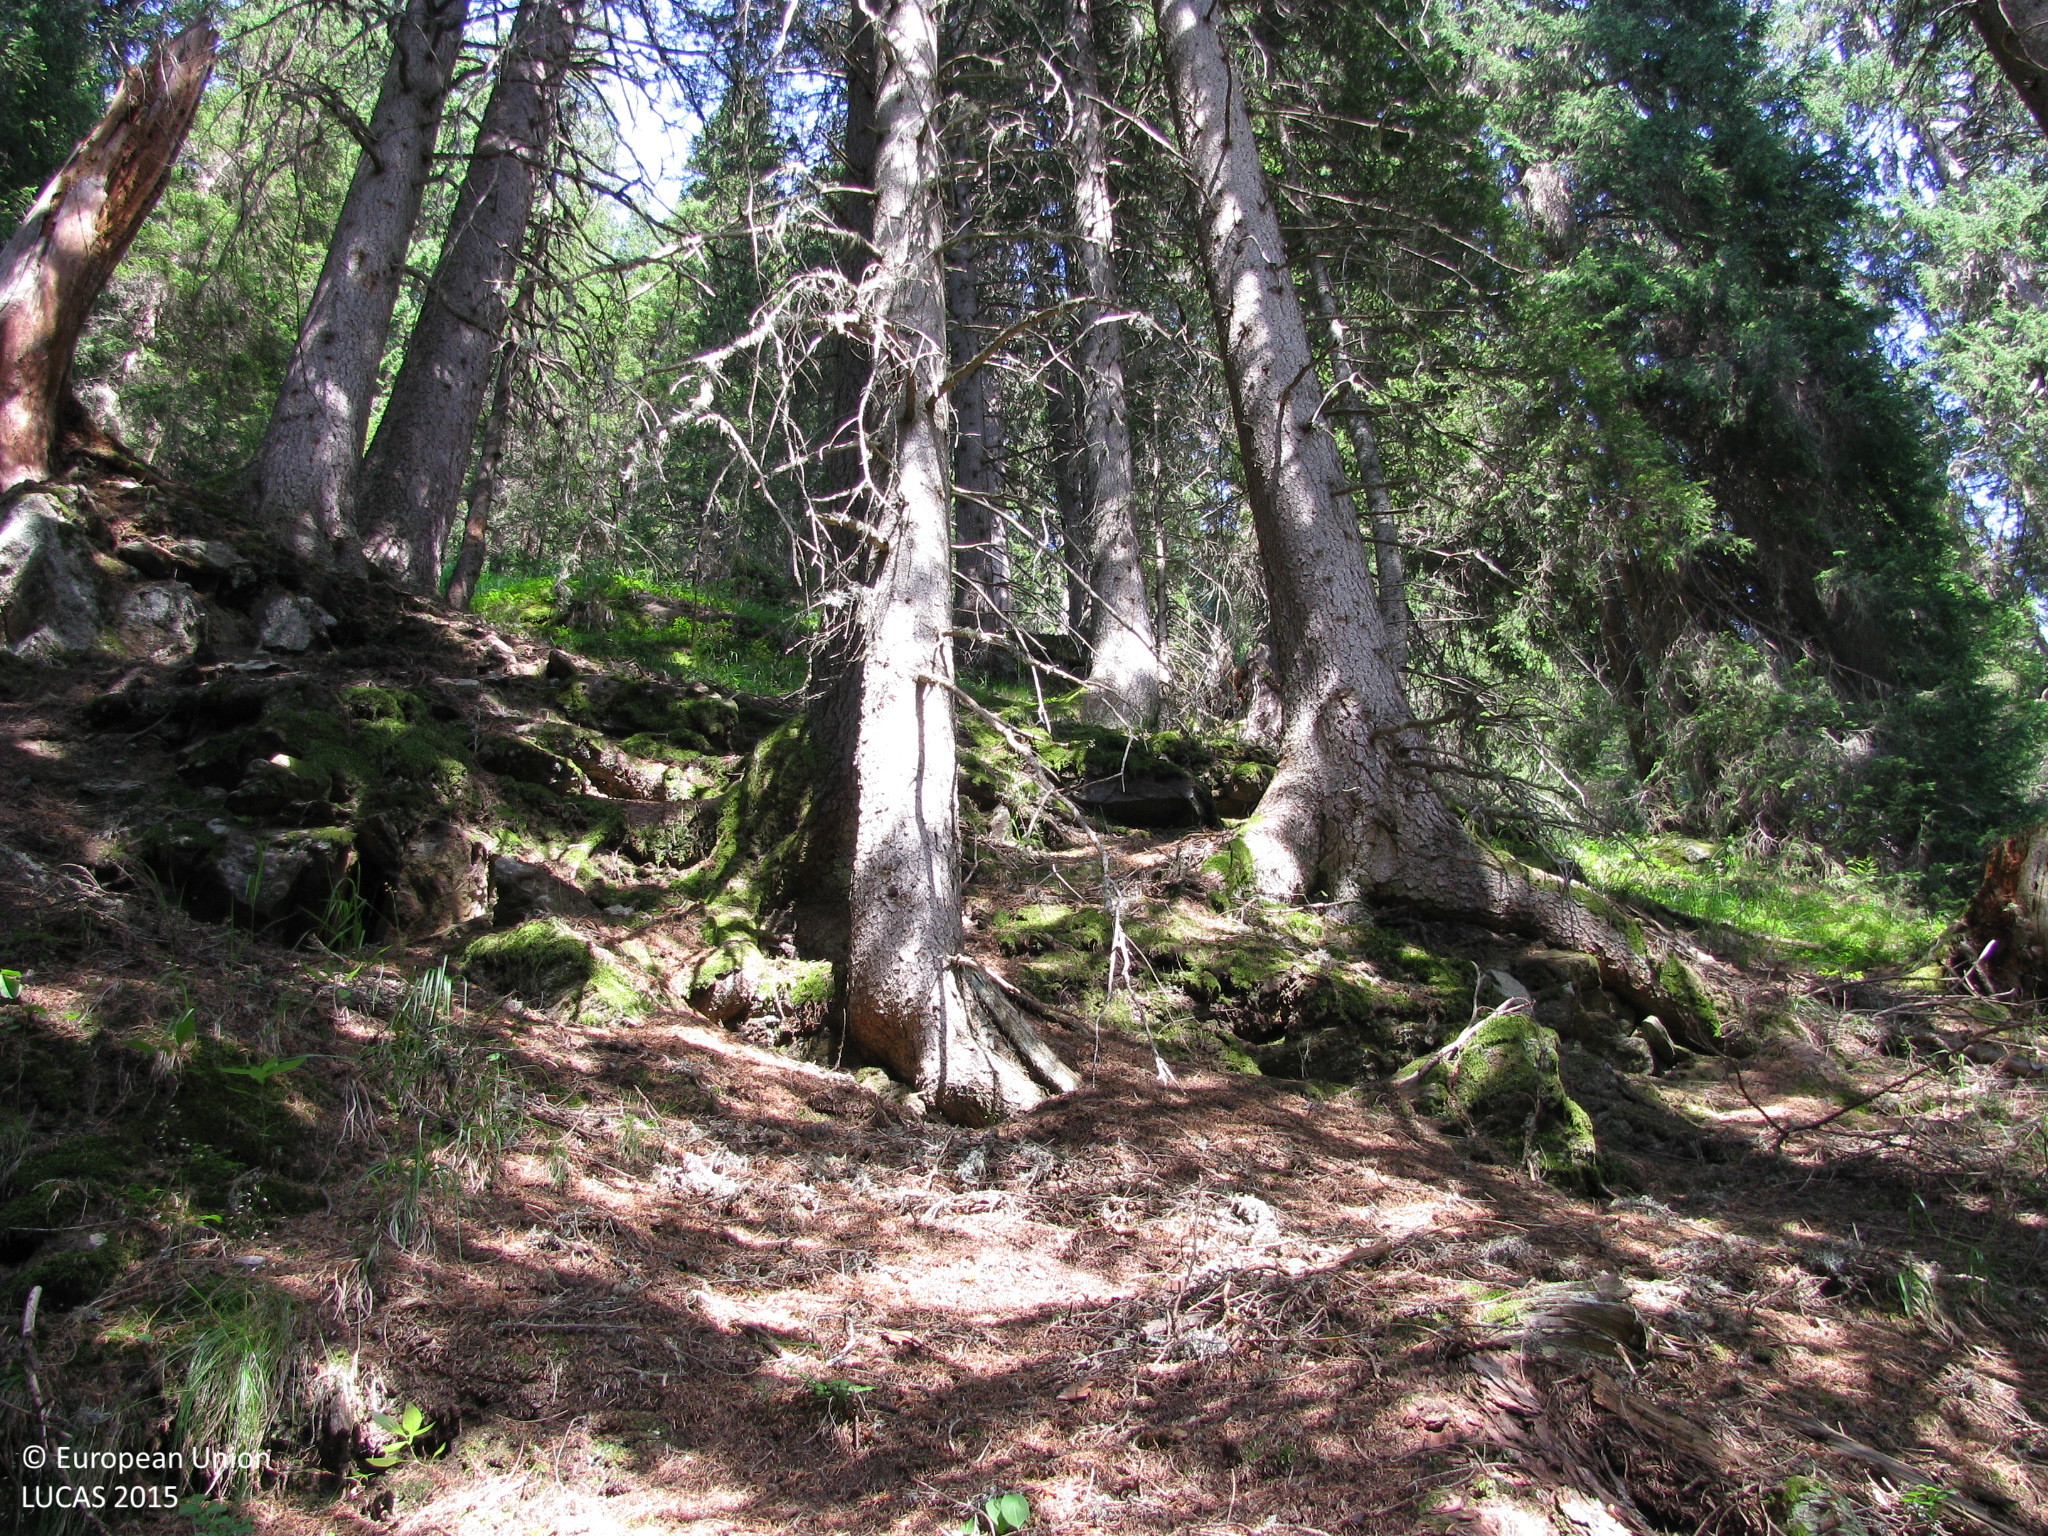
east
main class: Woodland
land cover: Spruce dominated coniferous woodland
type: alpine coniferous forest
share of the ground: > 75 %
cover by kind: coniferous forest trees 85 %, herbaceous plants 10 %, unconsolidated bare surface 5 %
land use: Forestry
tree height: > 5 m
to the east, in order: Spruce dominated coniferous woodland; Tracks; Spruce dominated coniferous woodland; Tracks; Spruce dominated coniferous woodland; Tracks; Spruce dominated coniferous woodland; Tracks; Spruce dominated coniferous woodland
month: July
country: AT
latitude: 46.7160
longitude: 12.6008
